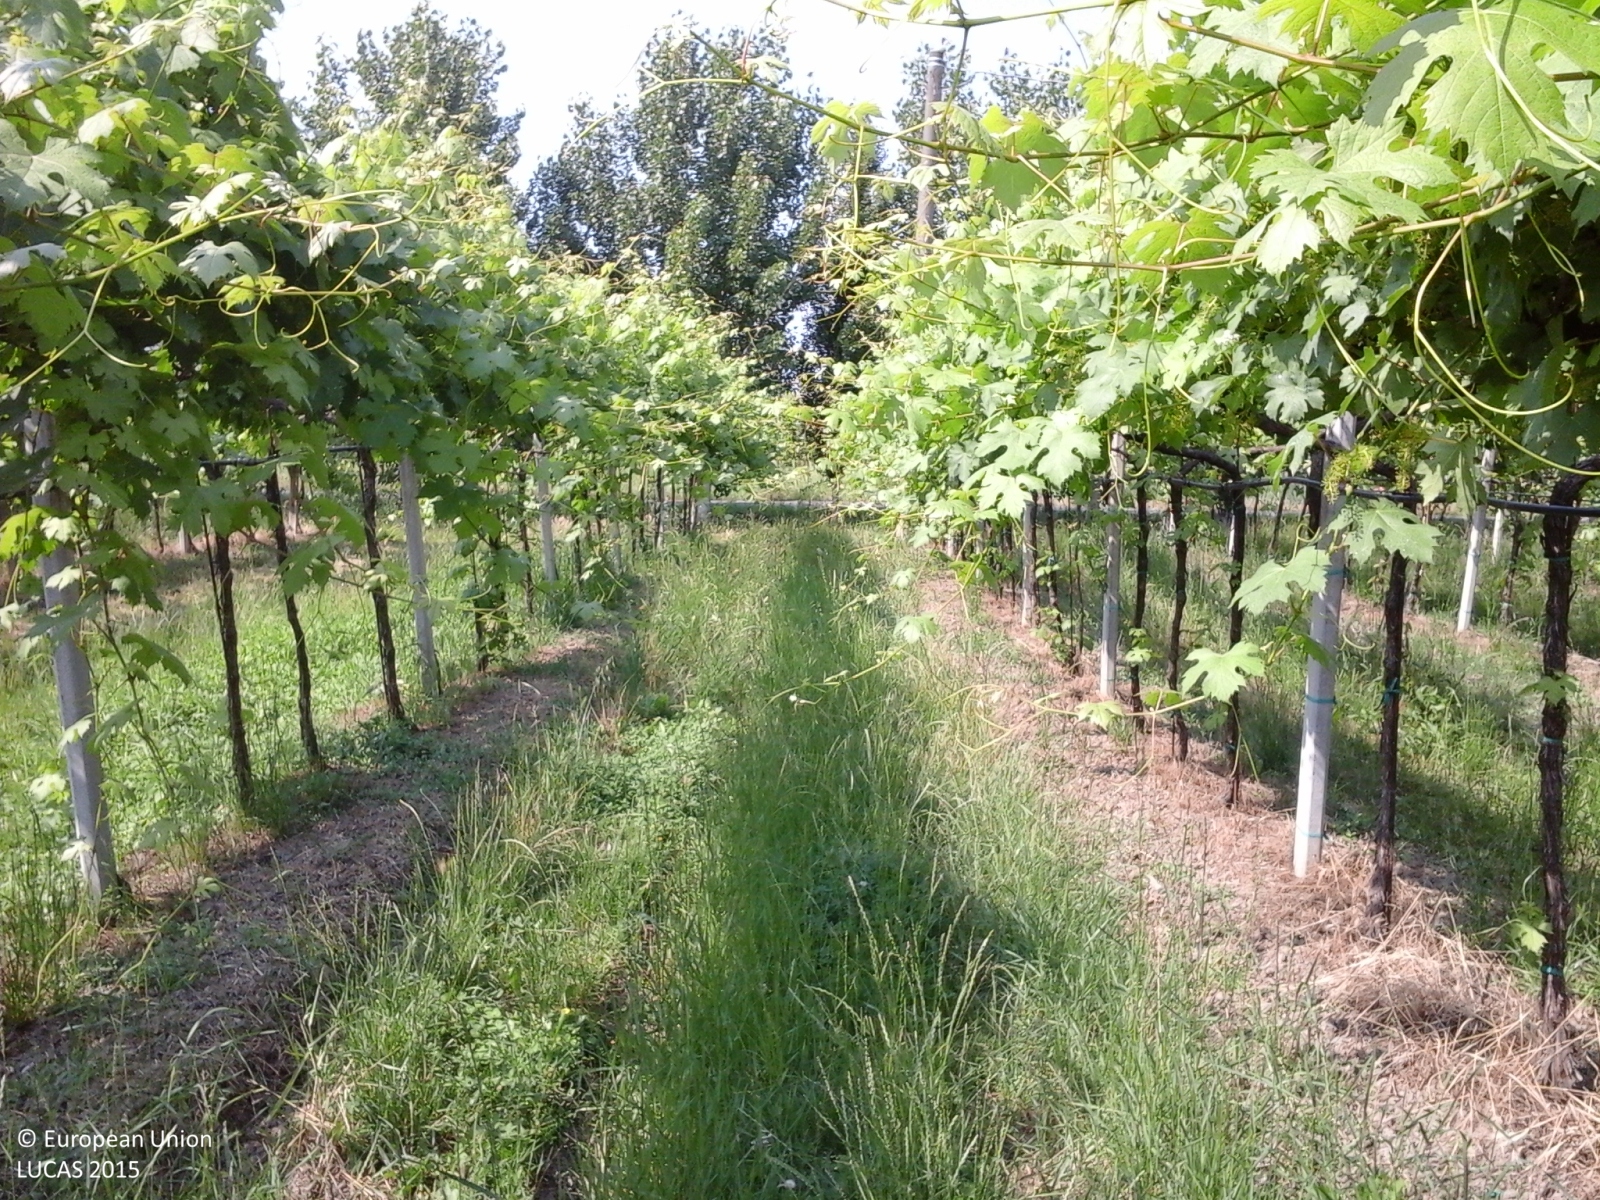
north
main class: Cropland
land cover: Vineyards
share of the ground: 25 - 50 %
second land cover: Grassland without tree/shrub cover
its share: 50 - 75 %
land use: Agriculture (excluding fallow land and kitchen gardens)
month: May
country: IT
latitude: 44.7448
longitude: 10.7184
